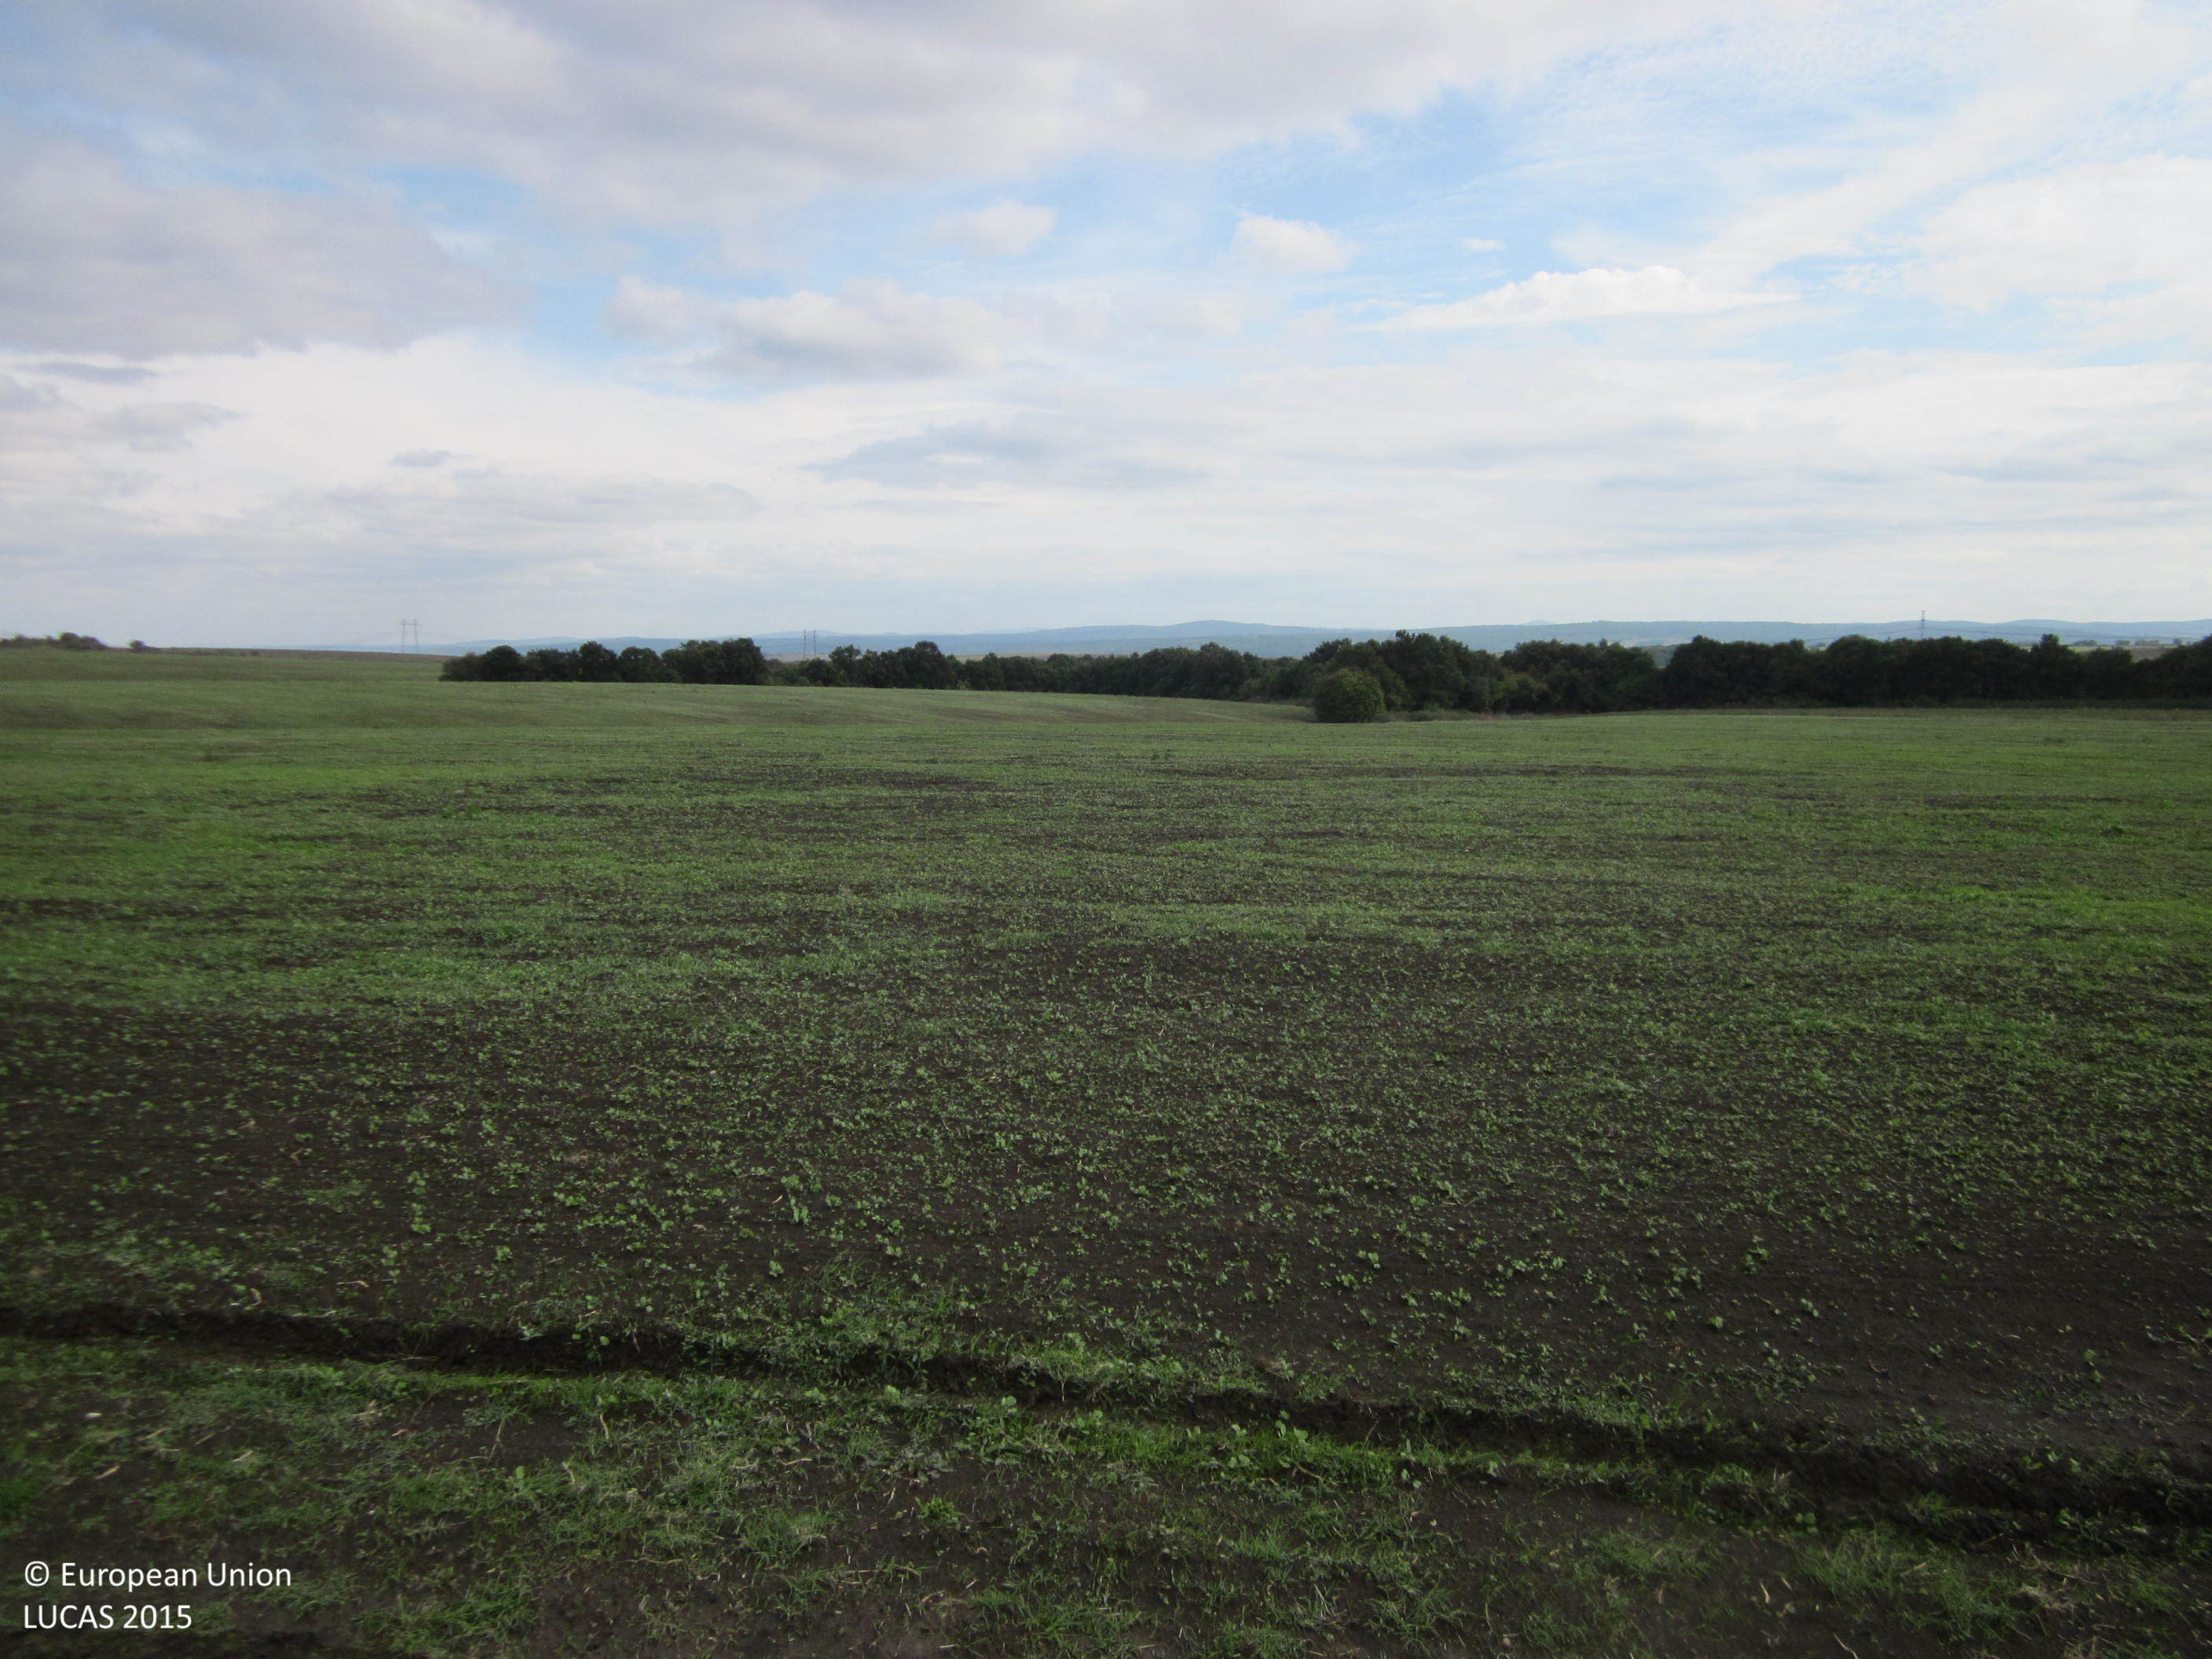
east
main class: Grassland
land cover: Spontaneously vegetated surfaces
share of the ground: > 75 %
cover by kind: herbaceous plants 100 %
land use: Fallow land
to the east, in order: Spontaneously vegetated surfaces; Other bare soil; Electric lines; Other bare soil; Single bushes/trees; Other bare soil
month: October
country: BG
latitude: 42.3442
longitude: 27.0117
